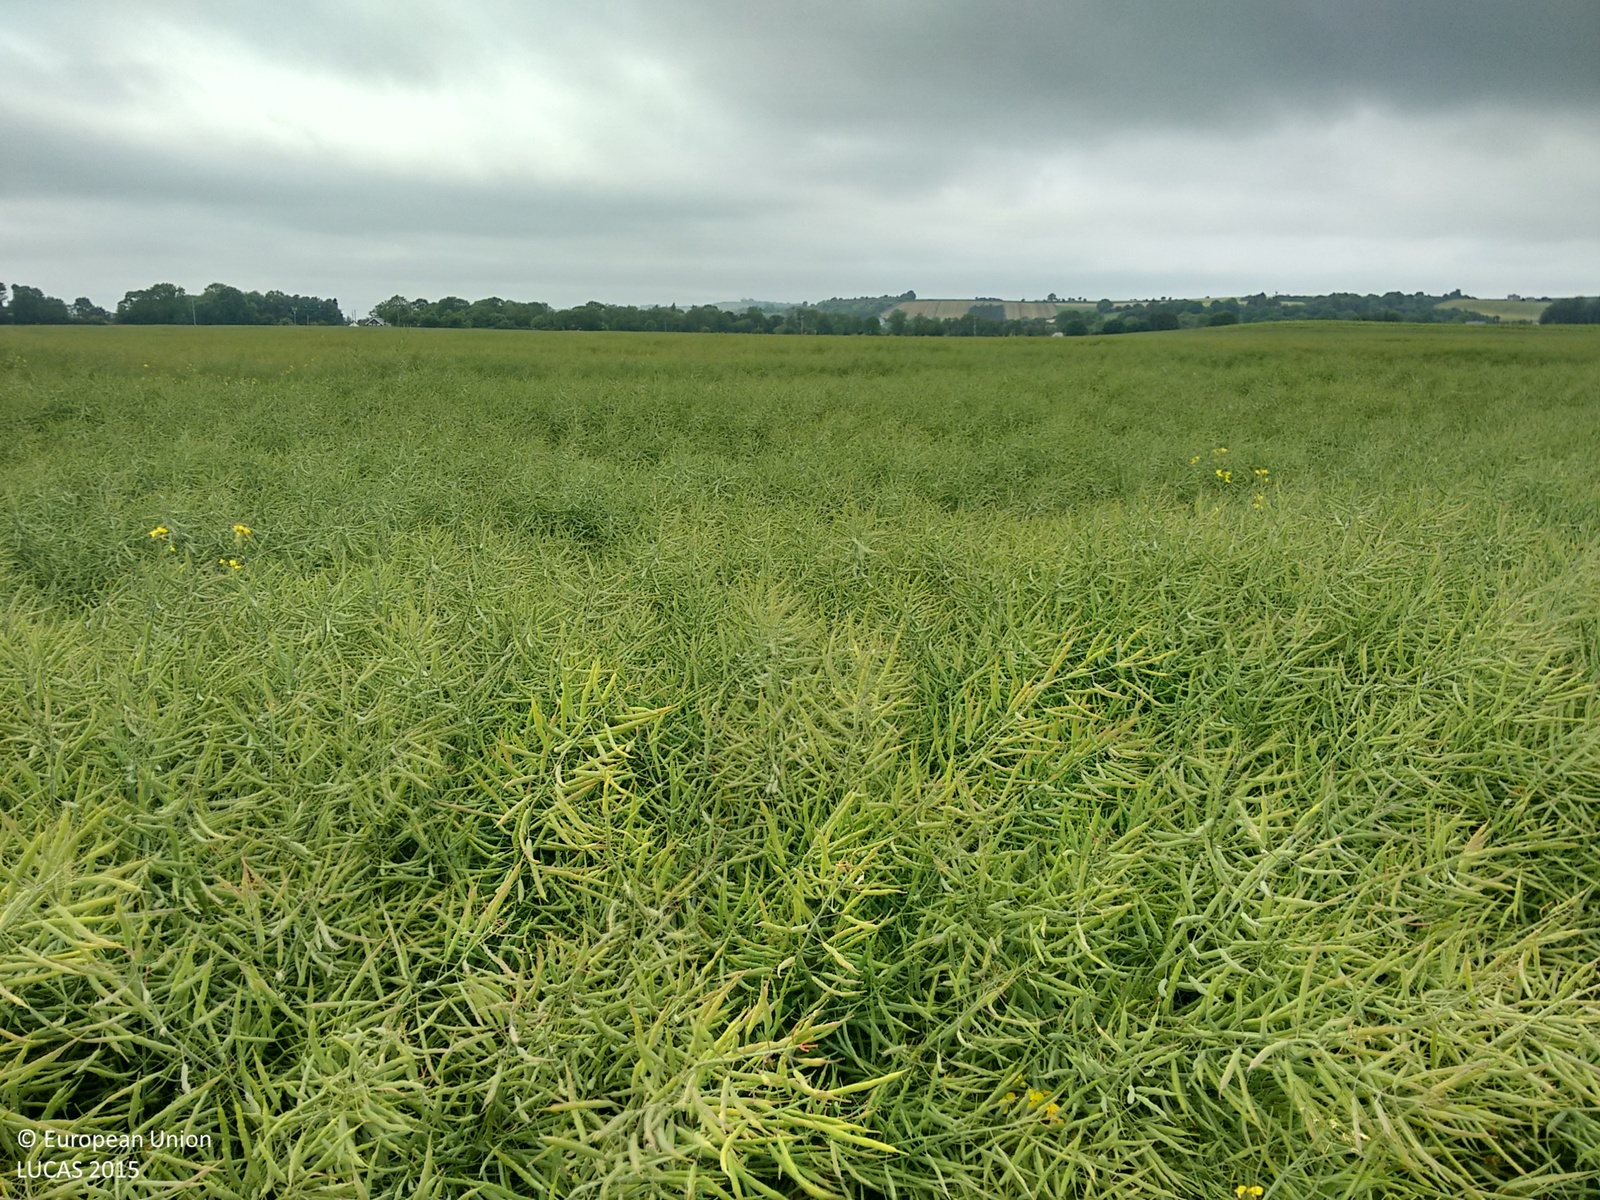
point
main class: Cropland
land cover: Rape and turnip rape
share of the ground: > 75 %
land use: Agriculture (excluding fallow land and kitchen gardens)
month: June
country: IE
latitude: 51.9355
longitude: -8.0536
